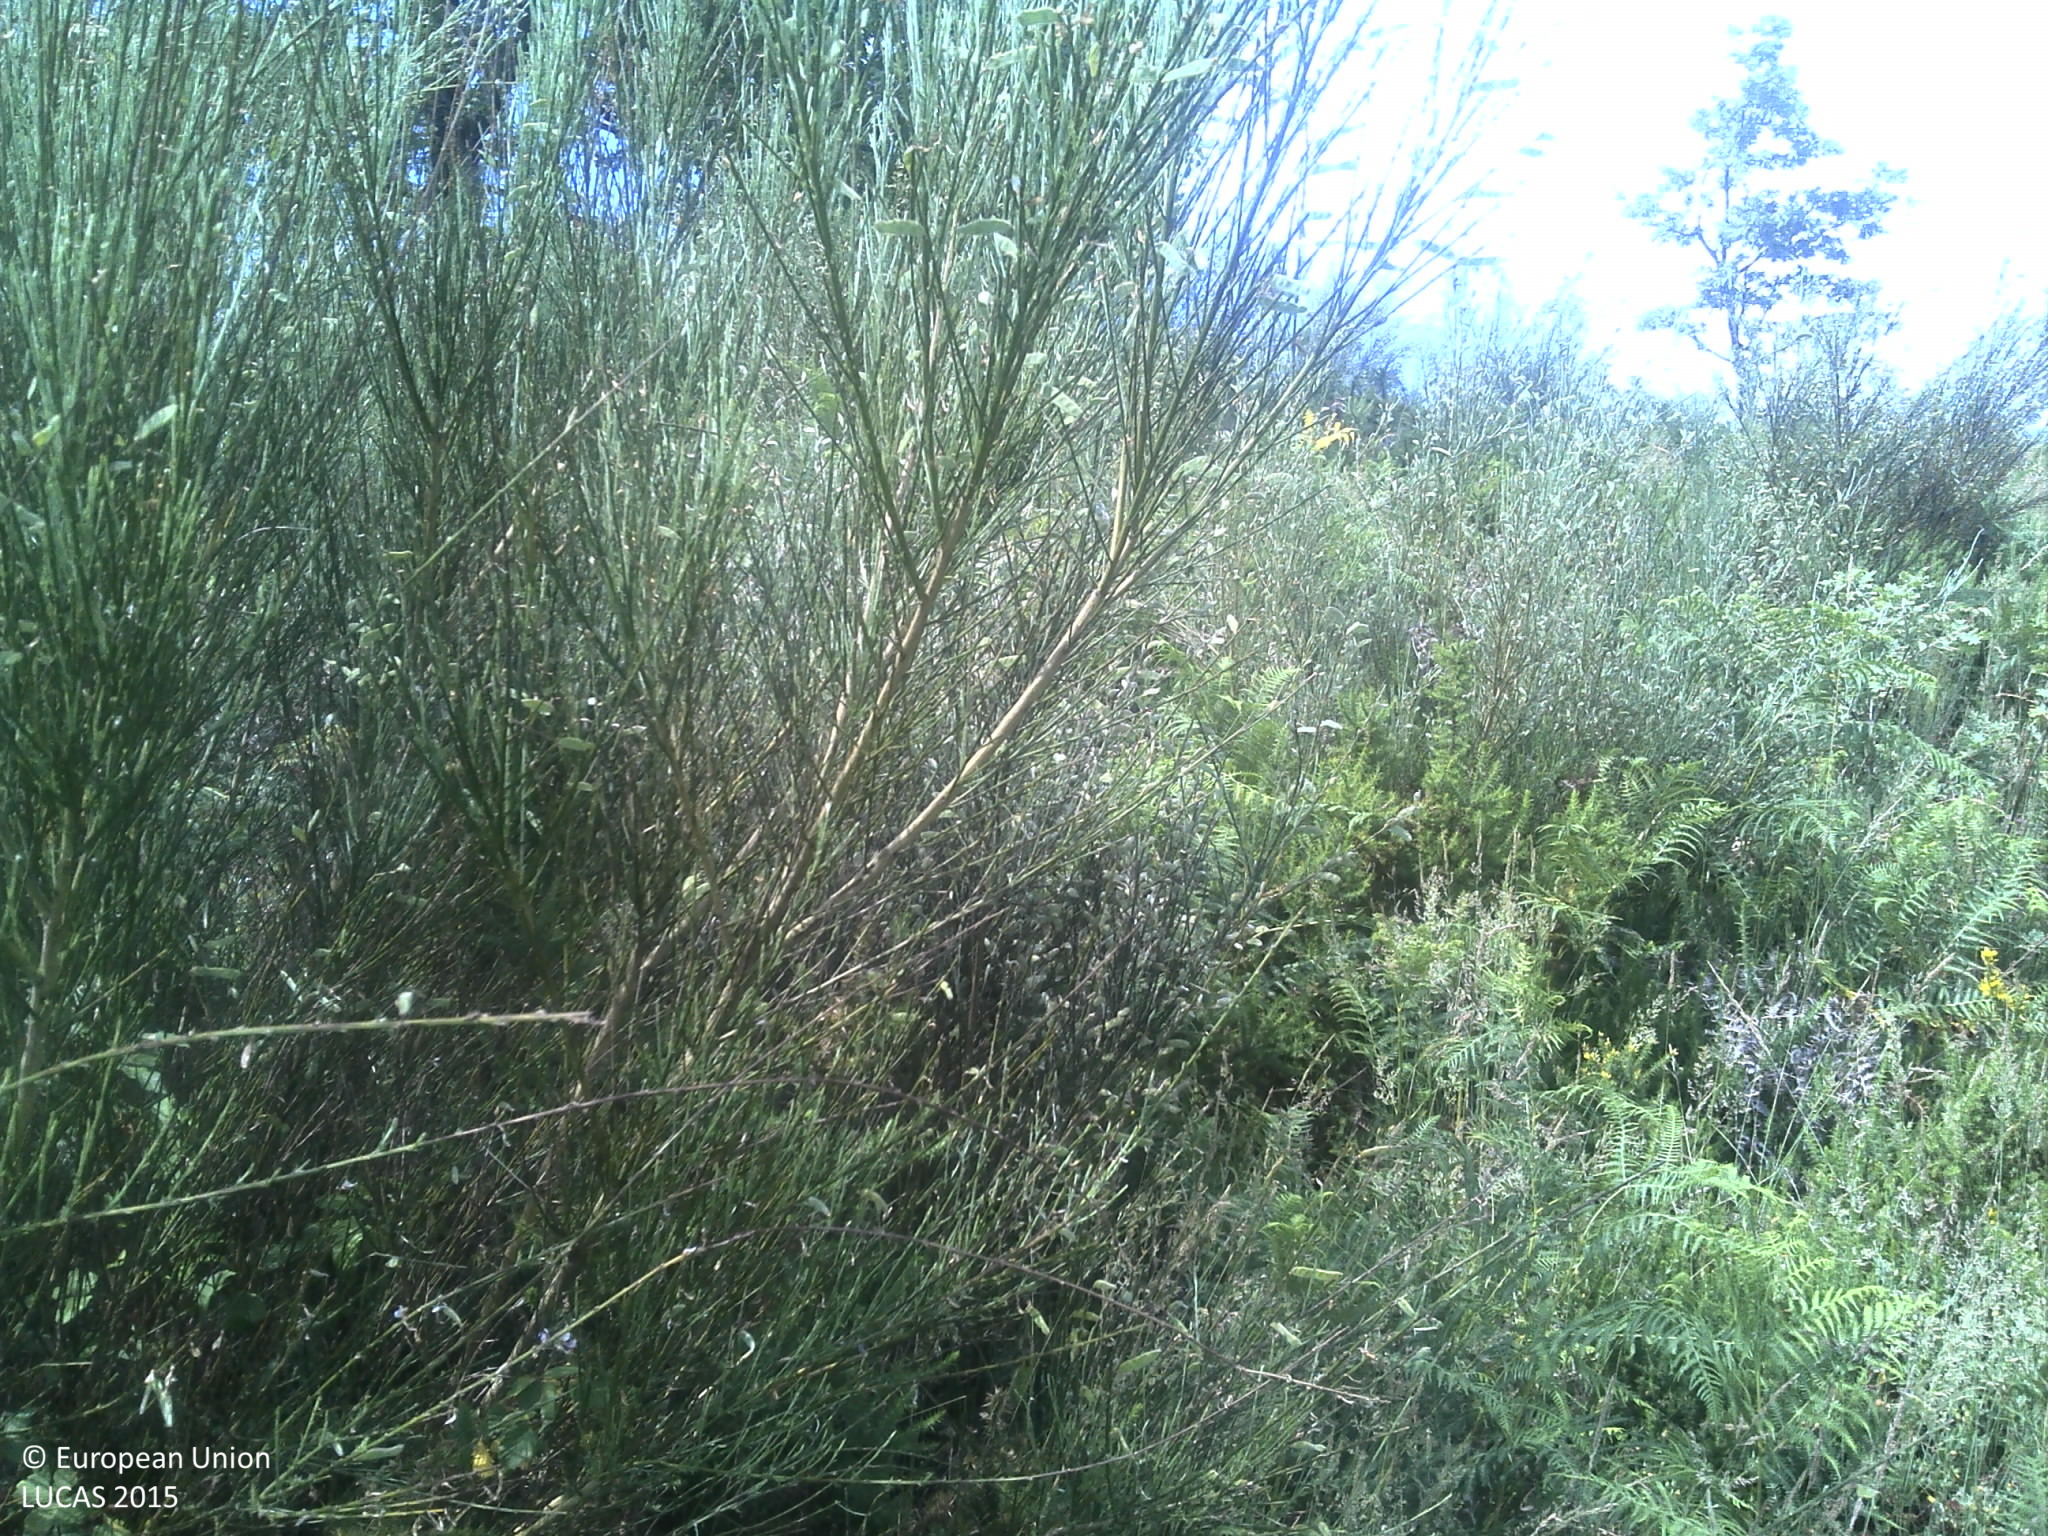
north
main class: Shrubland
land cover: Shrubland with sparse tree cover
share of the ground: > 75 %
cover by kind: shrubs 80 %, herbaceous plants 10 %, broadleaved forest trees 5 %, unconsolidated bare surface 5 %
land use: Semi-natural and natural areas not in use
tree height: > 5 m
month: June
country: PT
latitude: 41.6147
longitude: -8.2096
